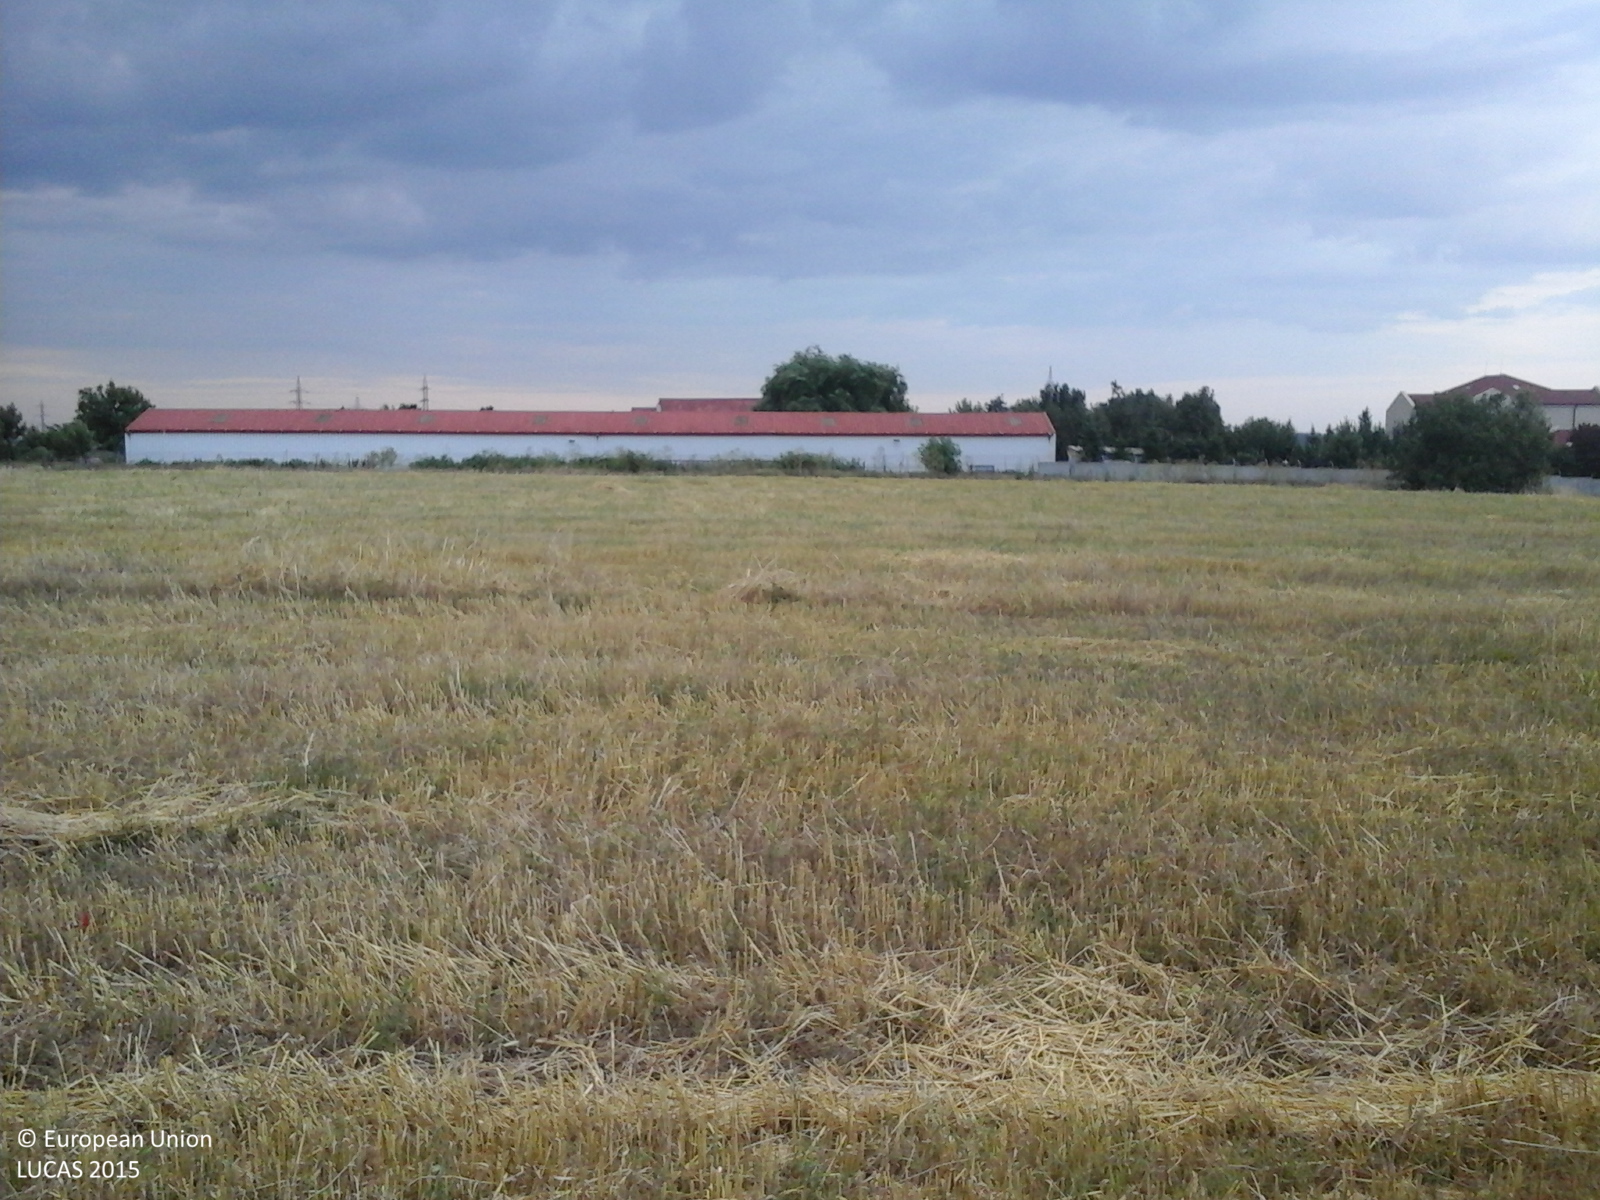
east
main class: Cropland
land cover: Common wheat
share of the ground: < 10 %
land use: Agriculture (excluding fallow land and kitchen gardens)
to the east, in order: Common wheat; Artificial constructions in urban areas; Spontaneously vegetated surfaces
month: June
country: RO
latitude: 44.4404
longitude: 26.2281
